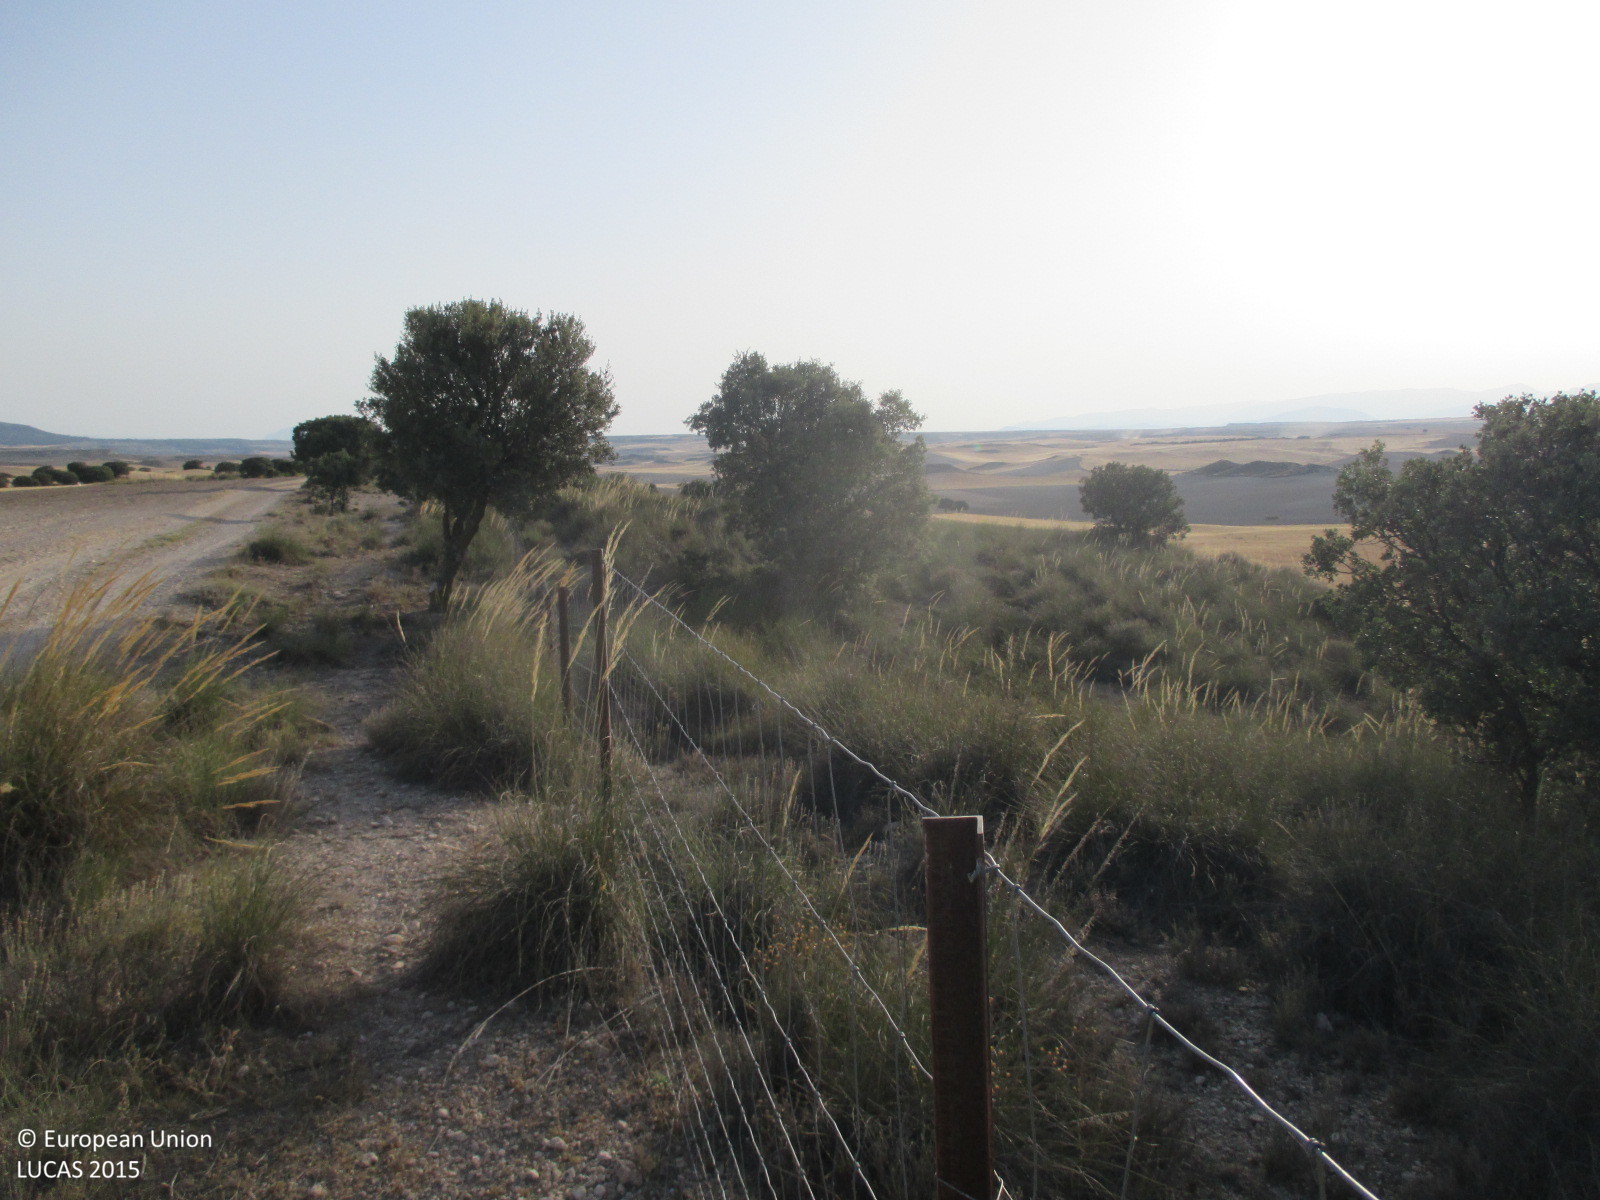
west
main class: Cropland
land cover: Oats
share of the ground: 25 - 50 %
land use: Agriculture (excluding fallow land and kitchen gardens)
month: June
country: ES
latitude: 37.7728
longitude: -2.4200
